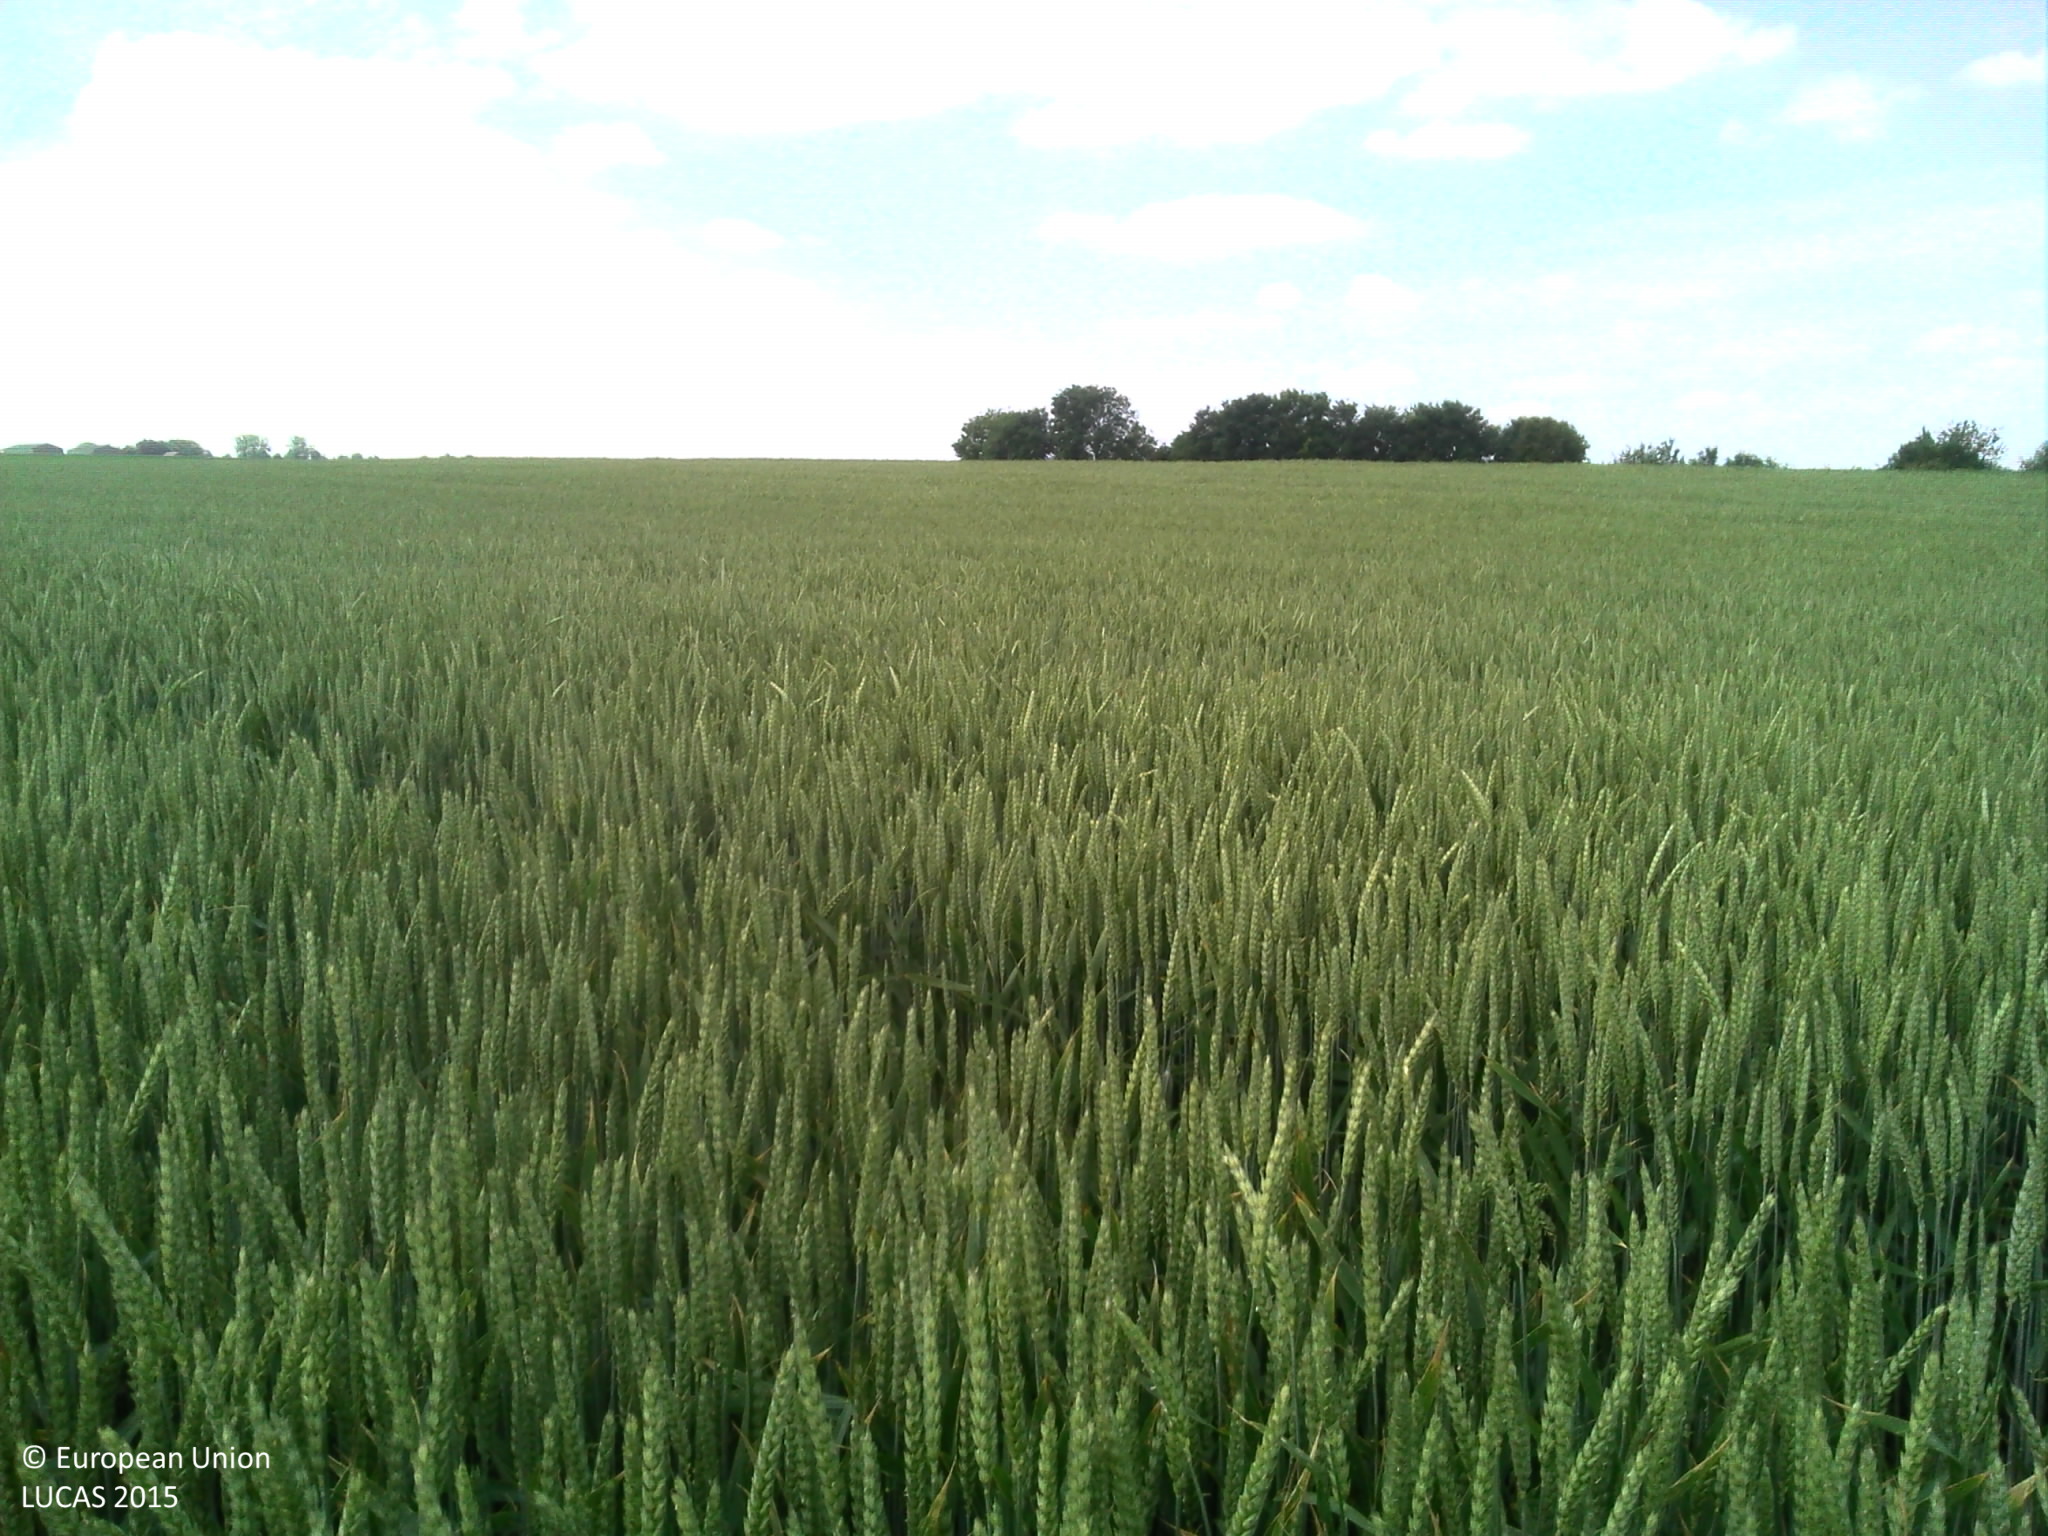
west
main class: Cropland
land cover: Common wheat
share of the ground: > 75 %
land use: Agriculture (excluding fallow land and kitchen gardens)
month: June
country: FR
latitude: 49.6780
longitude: 2.4067
